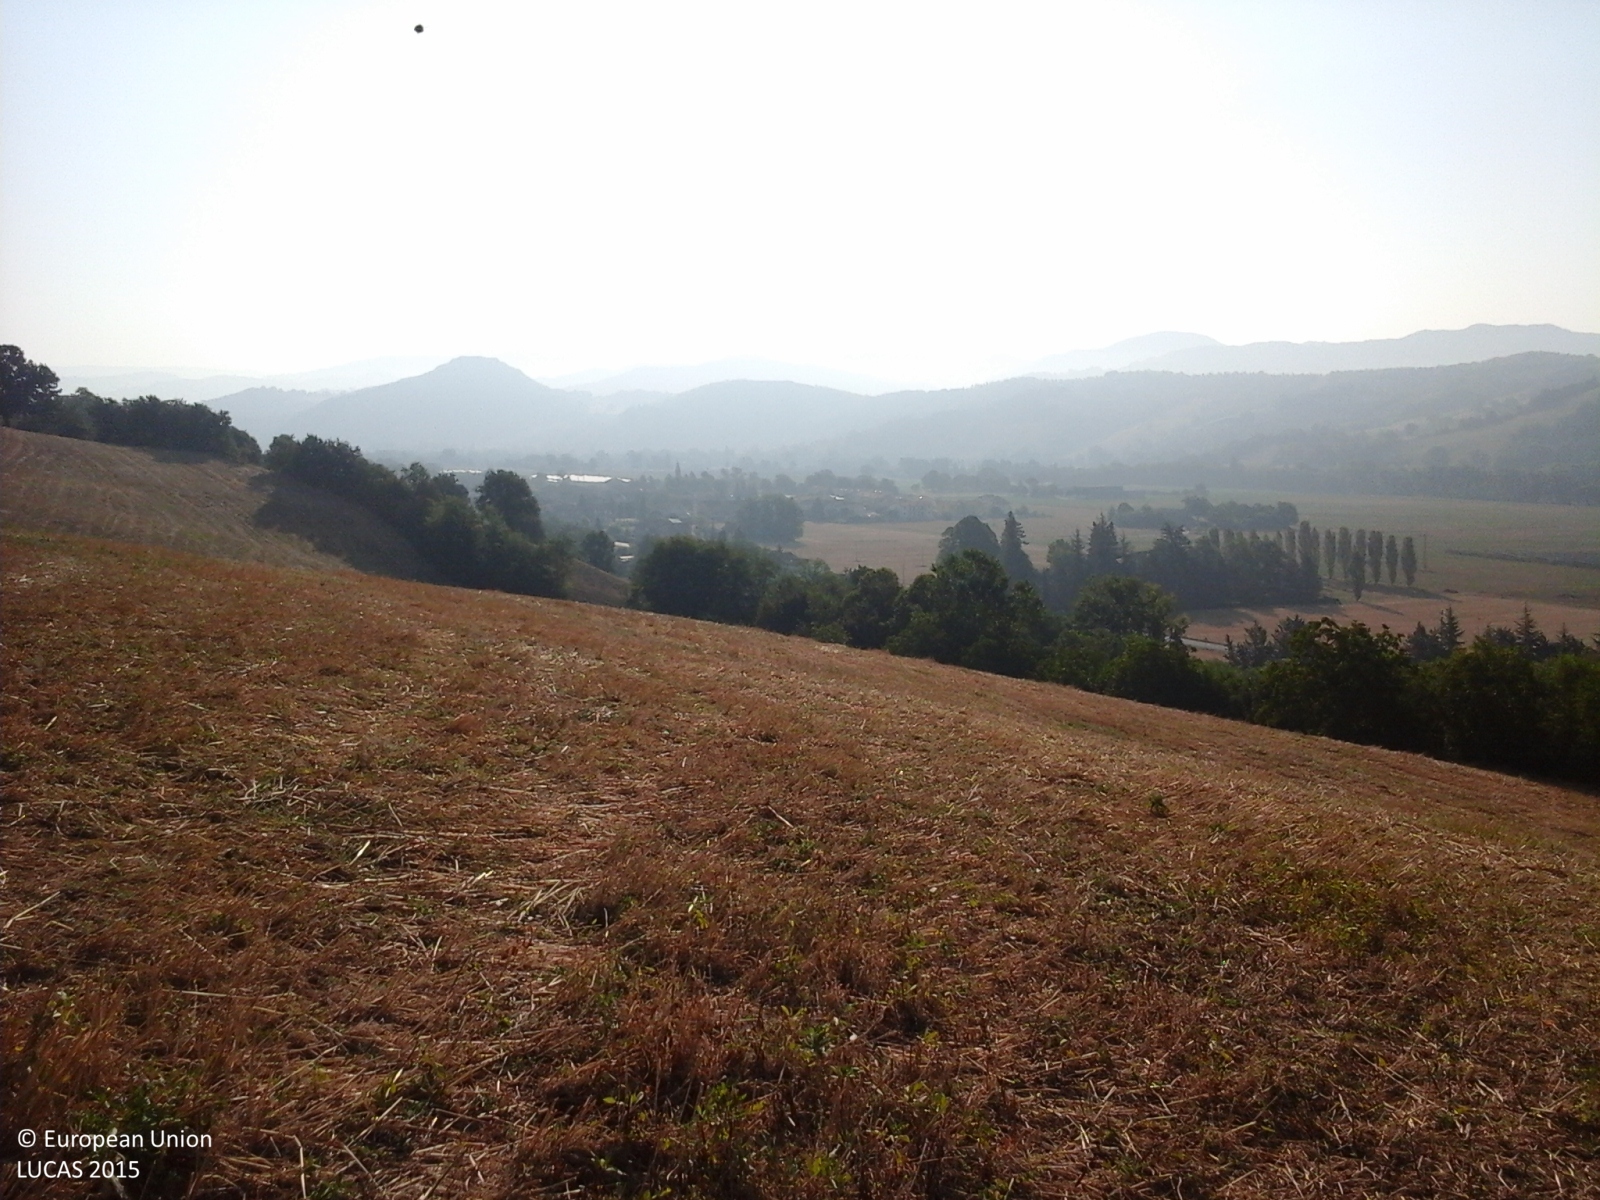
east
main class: Cropland
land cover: Common wheat
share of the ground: < 10 %
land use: Agriculture (excluding fallow land and kitchen gardens)
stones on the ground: < 10 %
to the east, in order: Common wheat; Broadleaved woodland
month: August
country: IT
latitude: 43.6506
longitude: 12.5847
